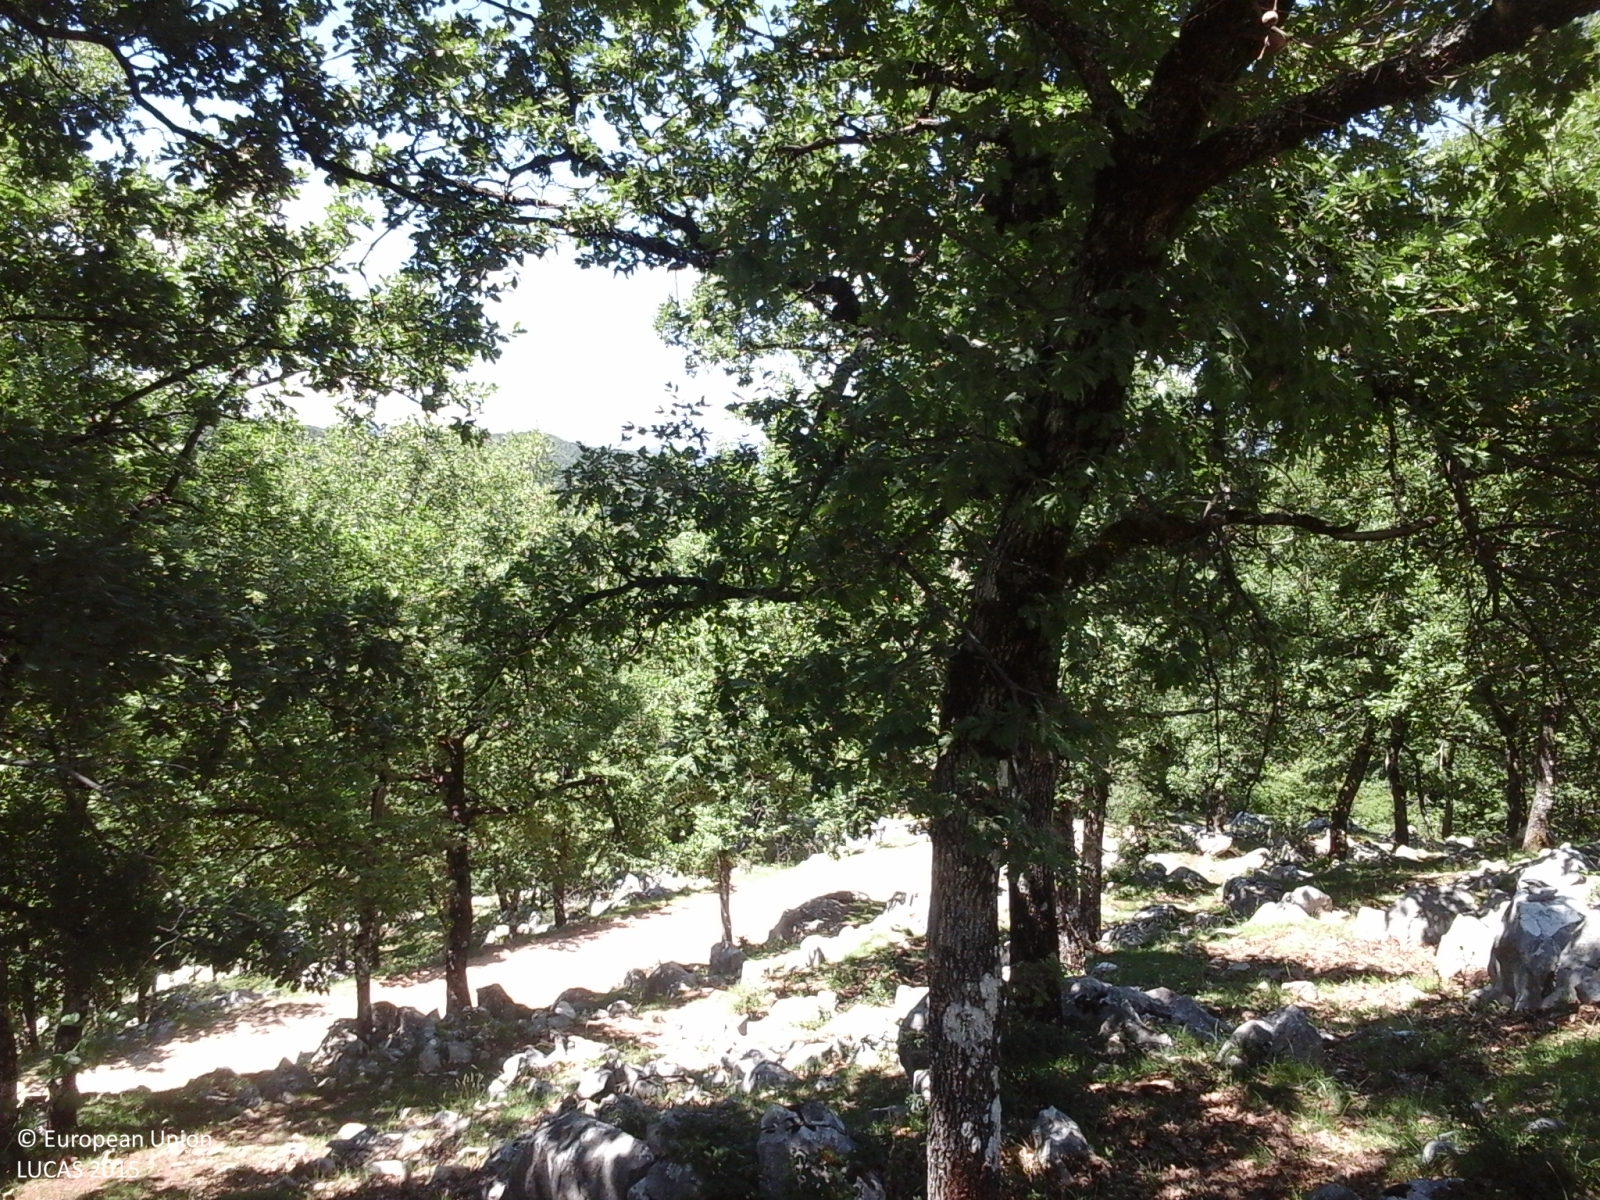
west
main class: Woodland
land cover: Broadleaved woodland
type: thermophilous deciduous forest
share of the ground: 50 - 75 %
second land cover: Grassland without tree/shrub cover
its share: > 75 %
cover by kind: herbaceous plants 50 %, broadleaved forest trees 40 %, shrubs 10 %
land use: Forestry
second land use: Agriculture (excluding fallow land and kitchen gardens)
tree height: > 5 m
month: June
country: IT
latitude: 41.6476
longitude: 13.1219
